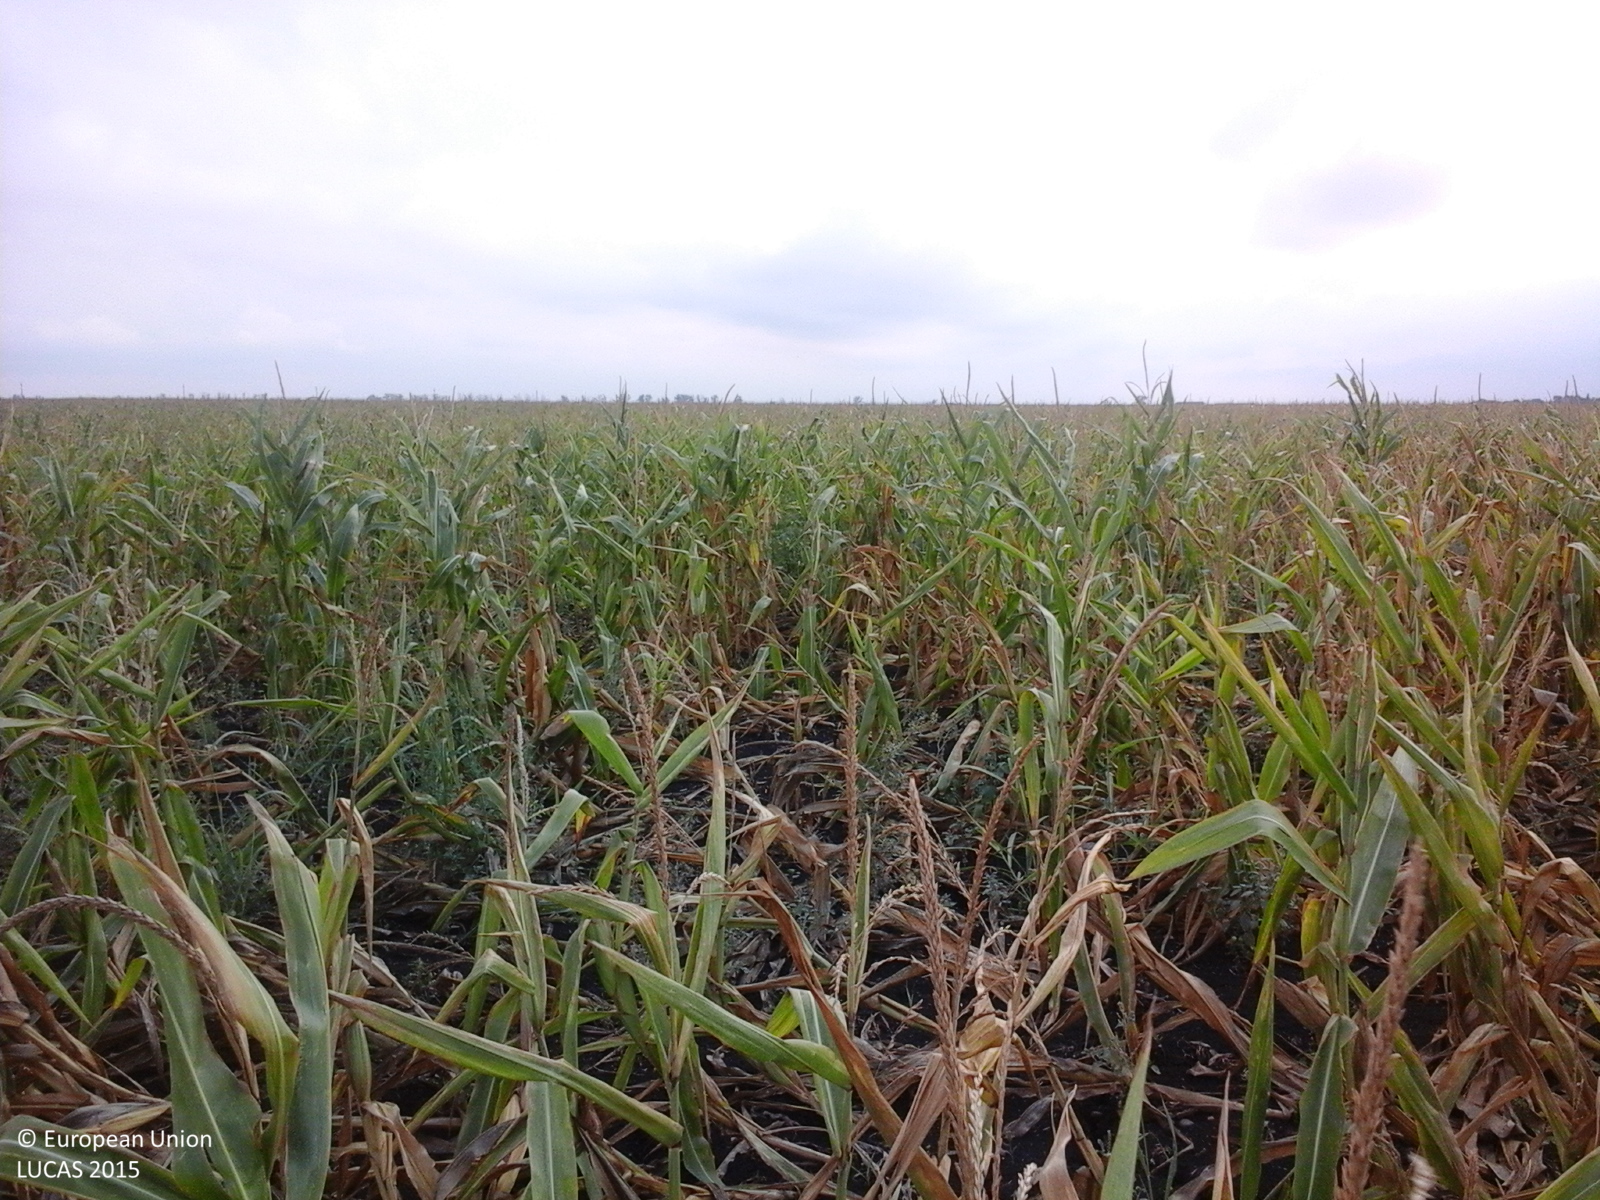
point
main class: Cropland
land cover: Maize
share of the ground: > 75 %
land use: Agriculture (excluding fallow land and kitchen gardens)
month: August
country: RO
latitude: 45.9587
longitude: 20.5141
